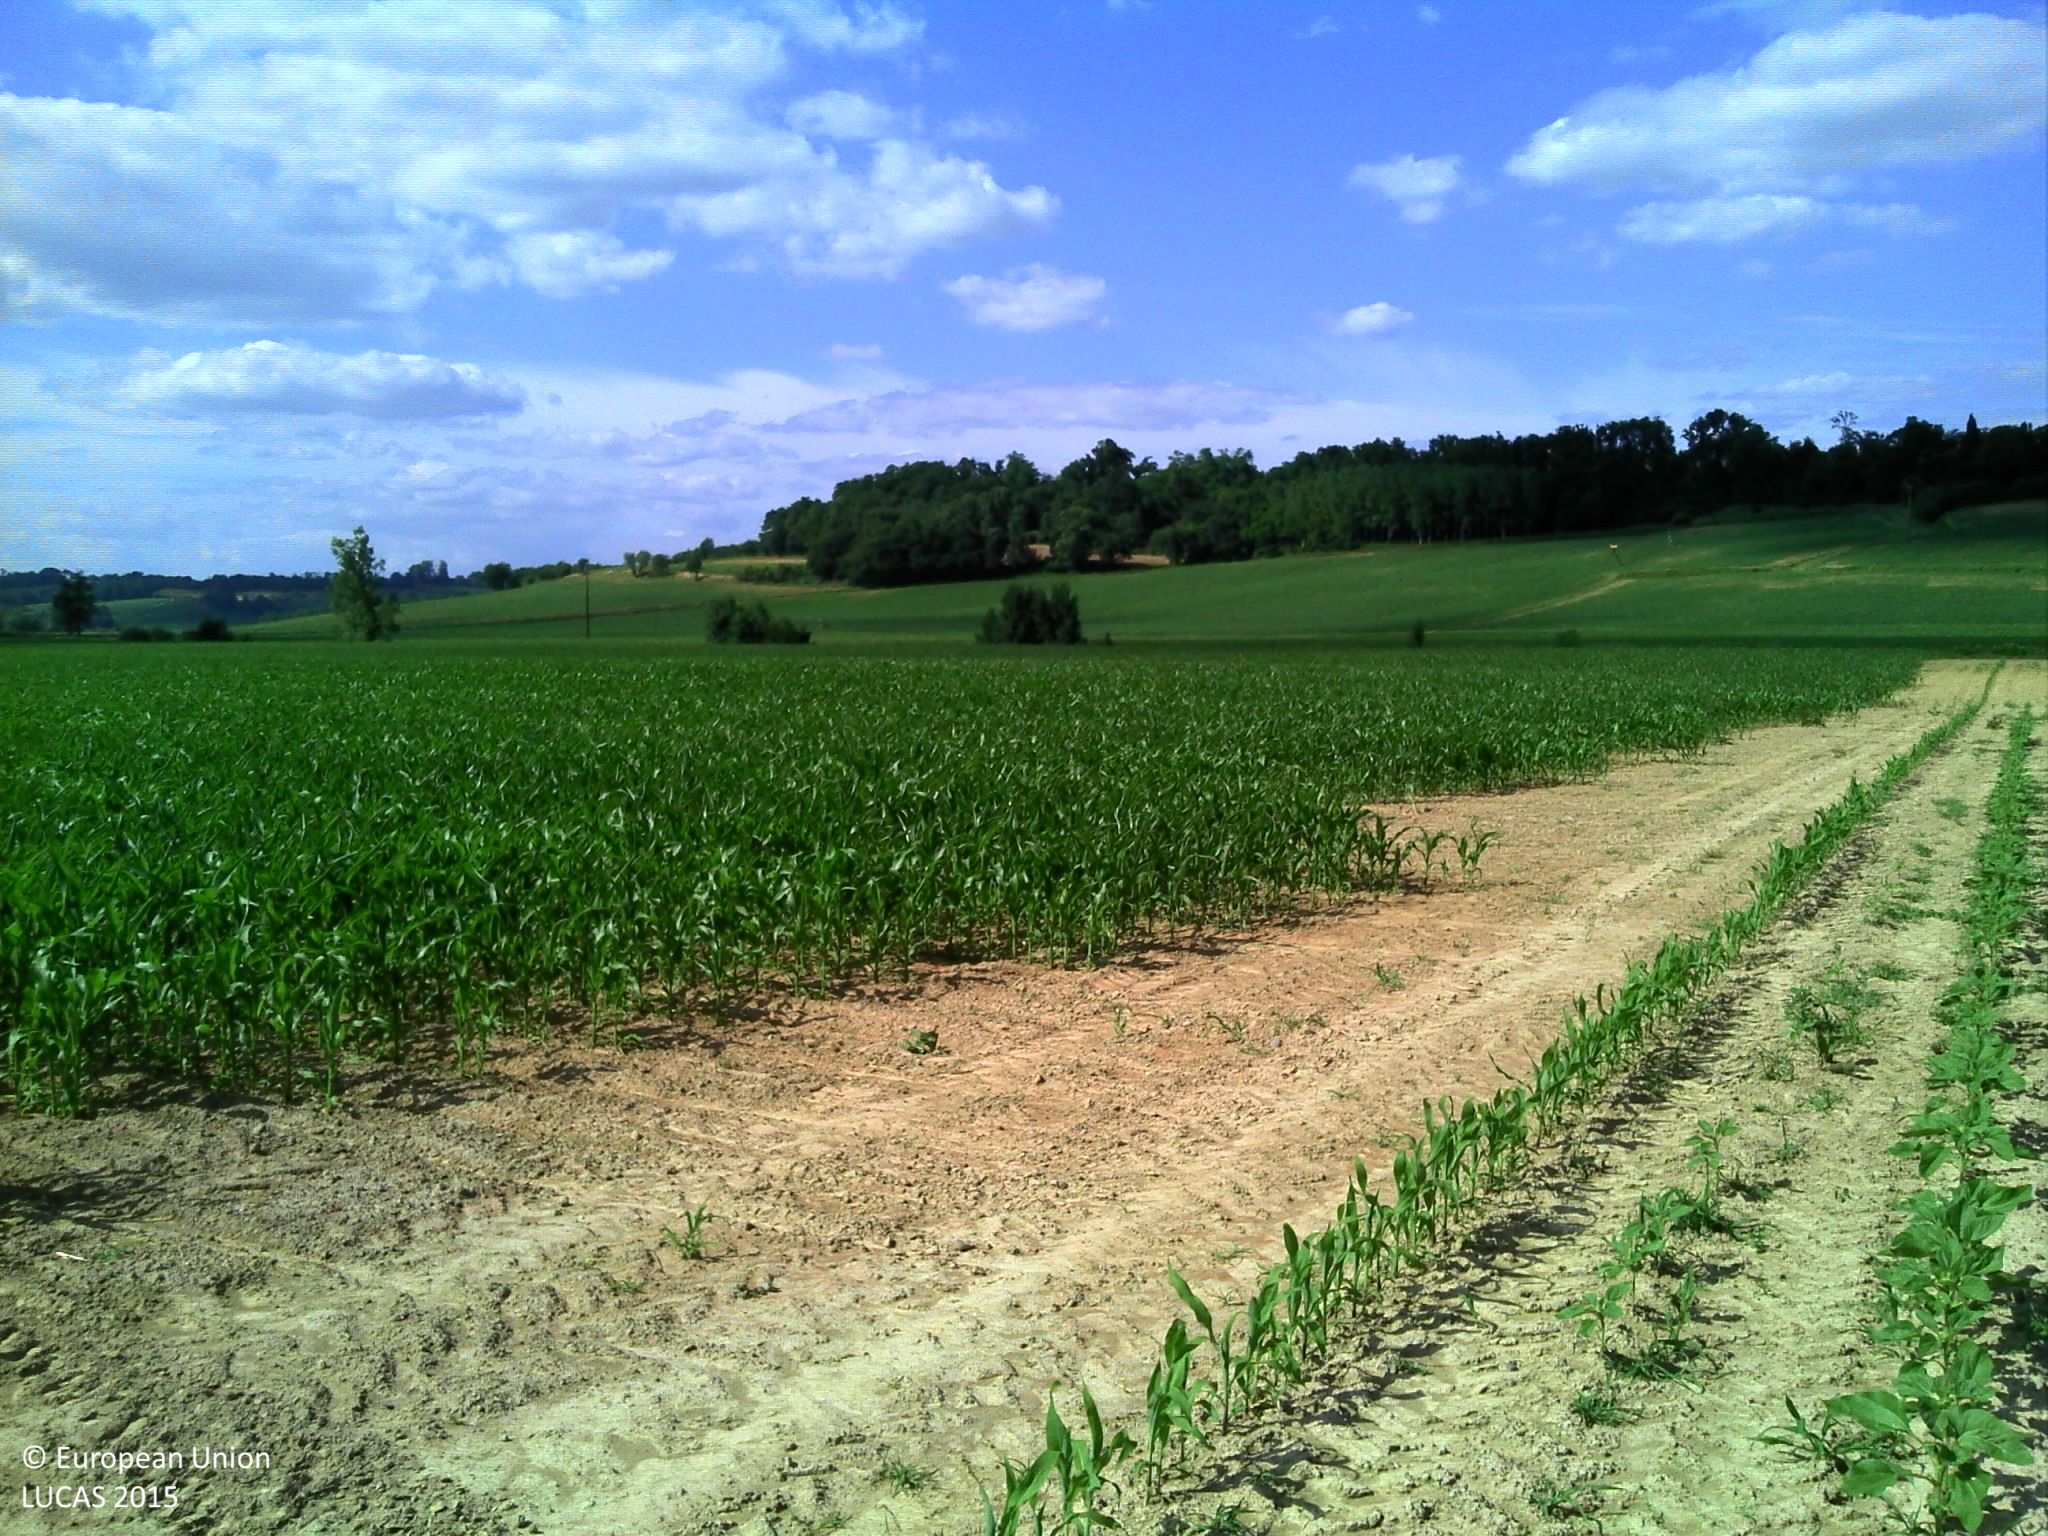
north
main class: Cropland
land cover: Sunflower
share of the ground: 50 - 75 %
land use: Agriculture (excluding fallow land and kitchen gardens)
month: June
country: FR
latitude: 43.6745
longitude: -0.4661
